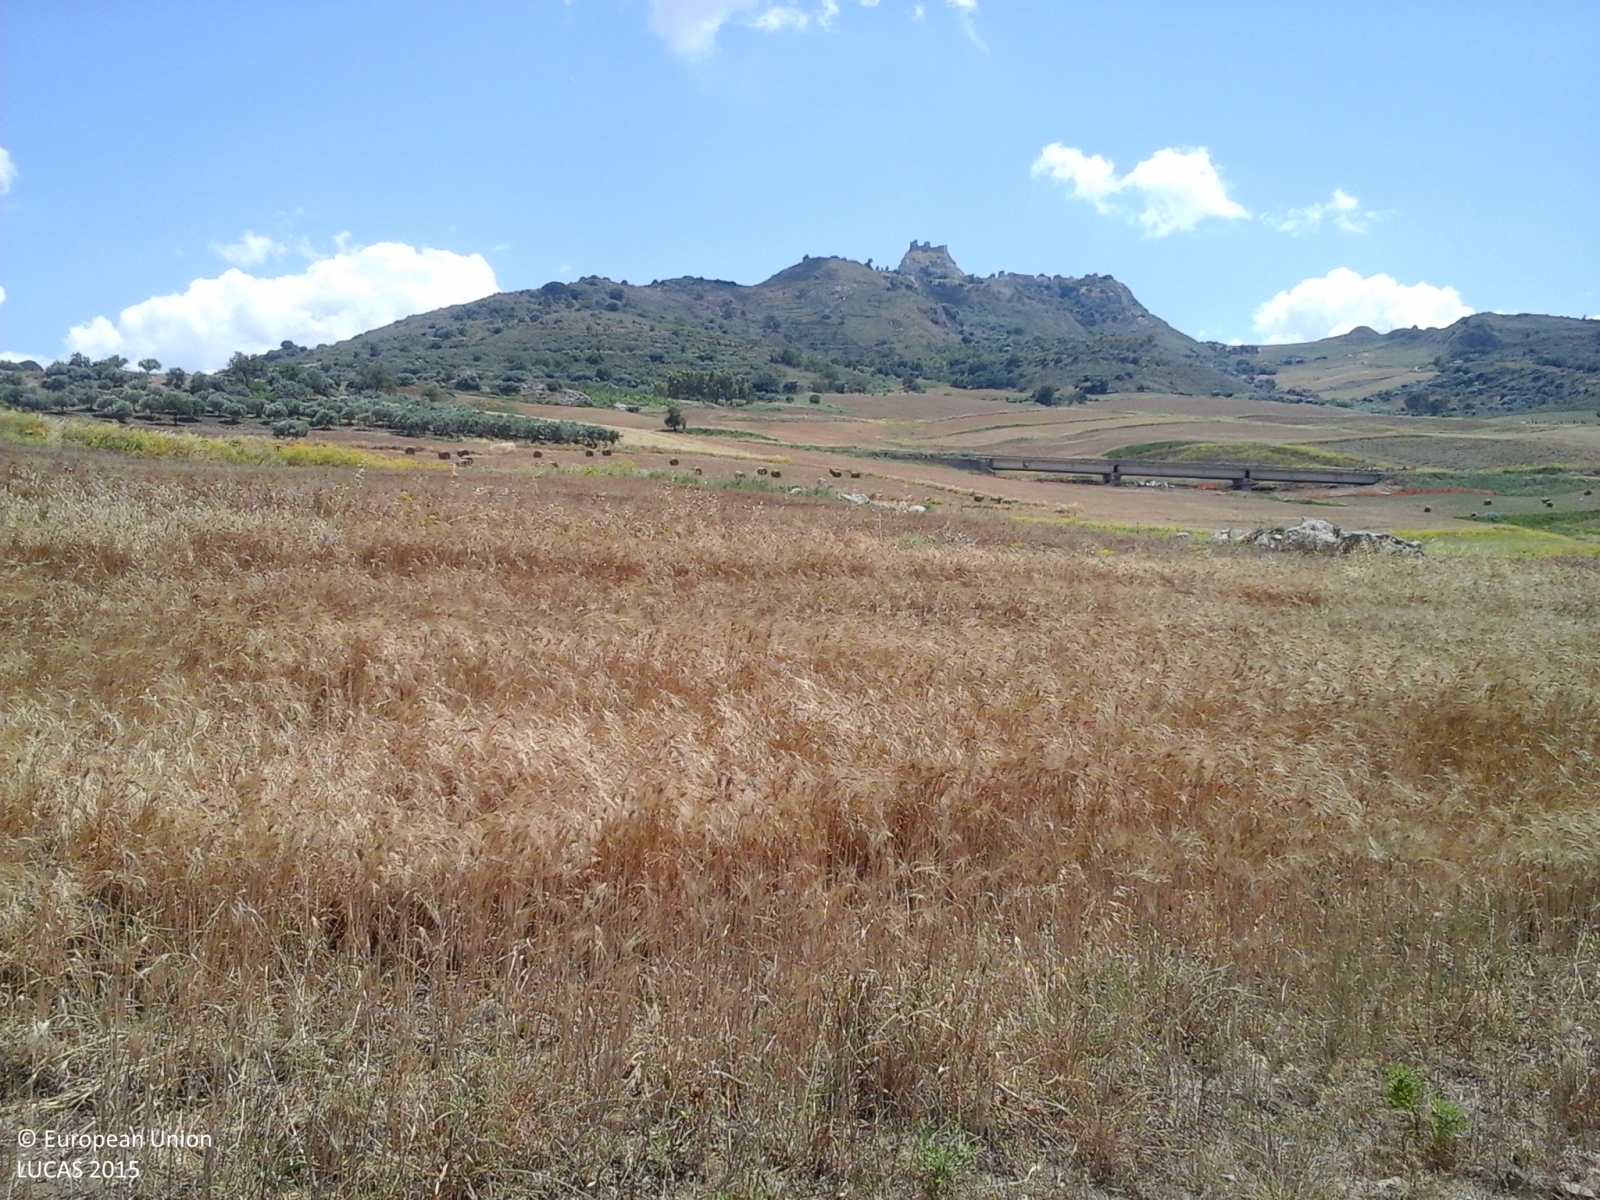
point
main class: Cropland
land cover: Durum wheat
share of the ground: > 75 %
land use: Agriculture (excluding fallow land and kitchen gardens)
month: June
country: IT
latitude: 37.8438
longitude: 13.5765
